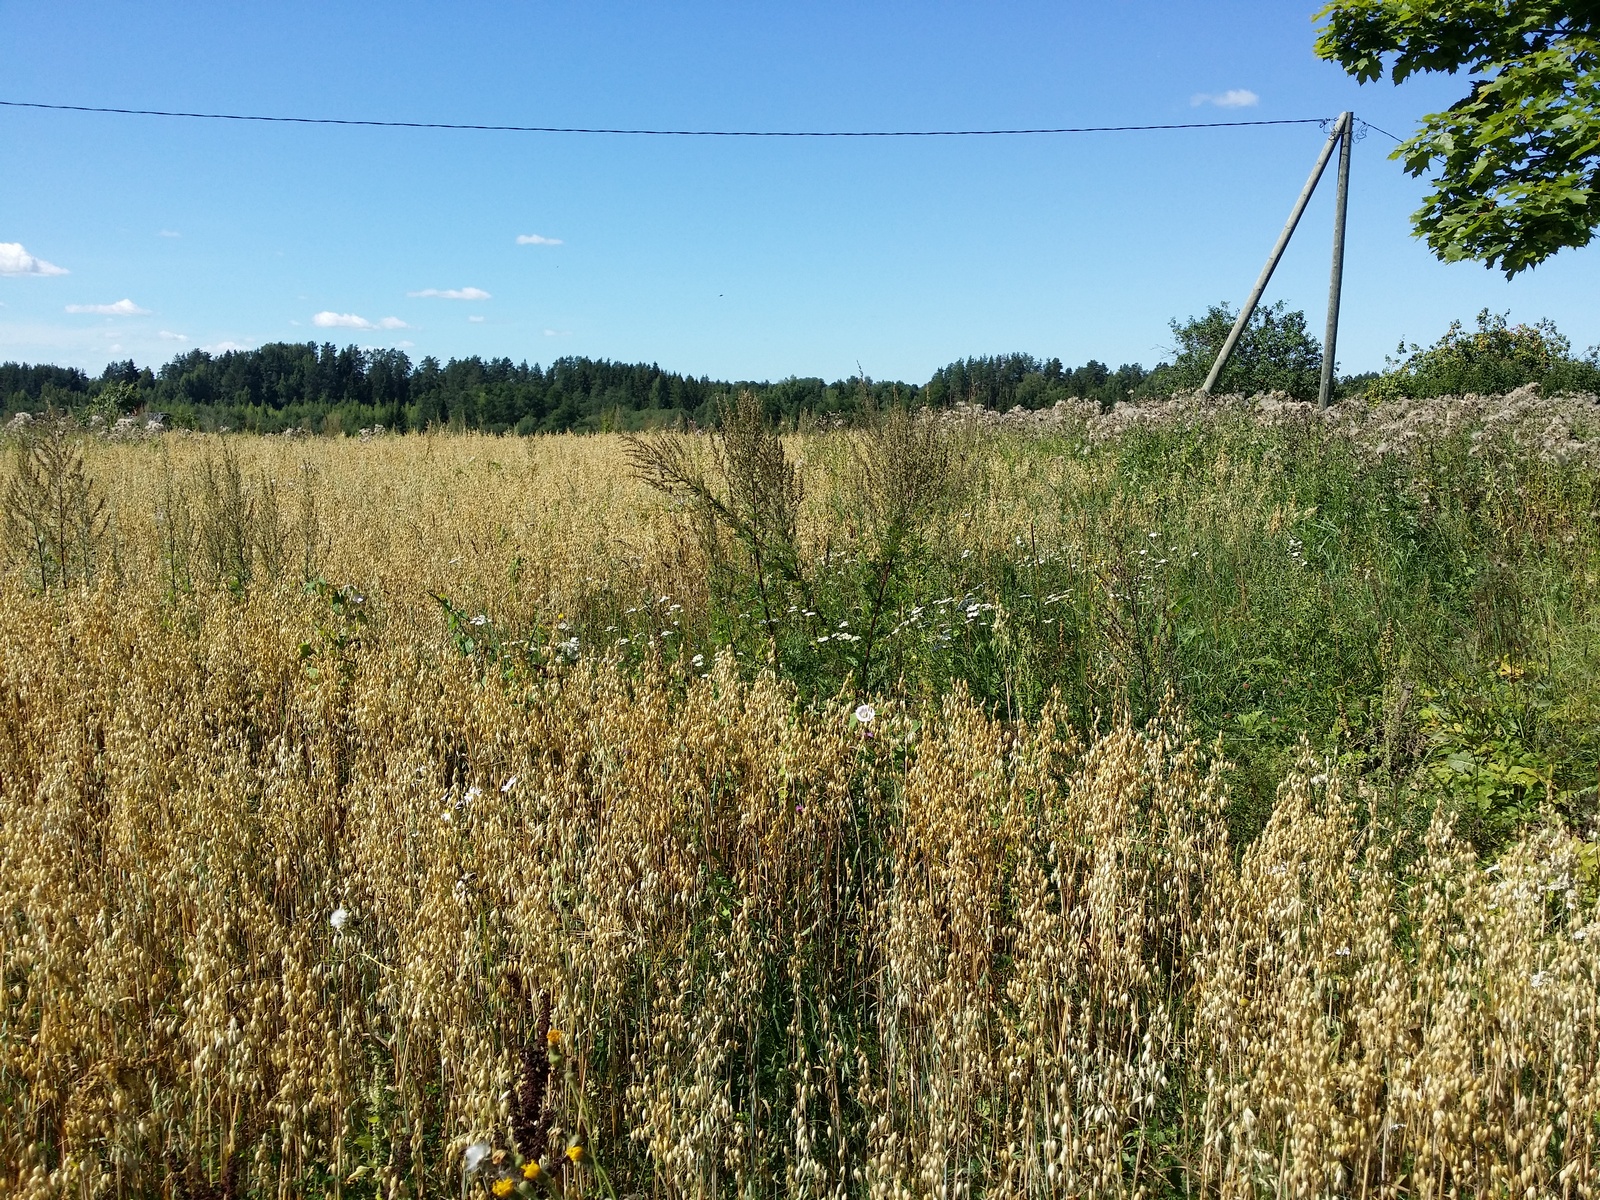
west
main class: Cropland
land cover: Oats
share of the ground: > 75 %
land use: Agriculture (excluding fallow land and kitchen gardens)
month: August
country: LV
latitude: 57.0386
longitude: 27.6331
